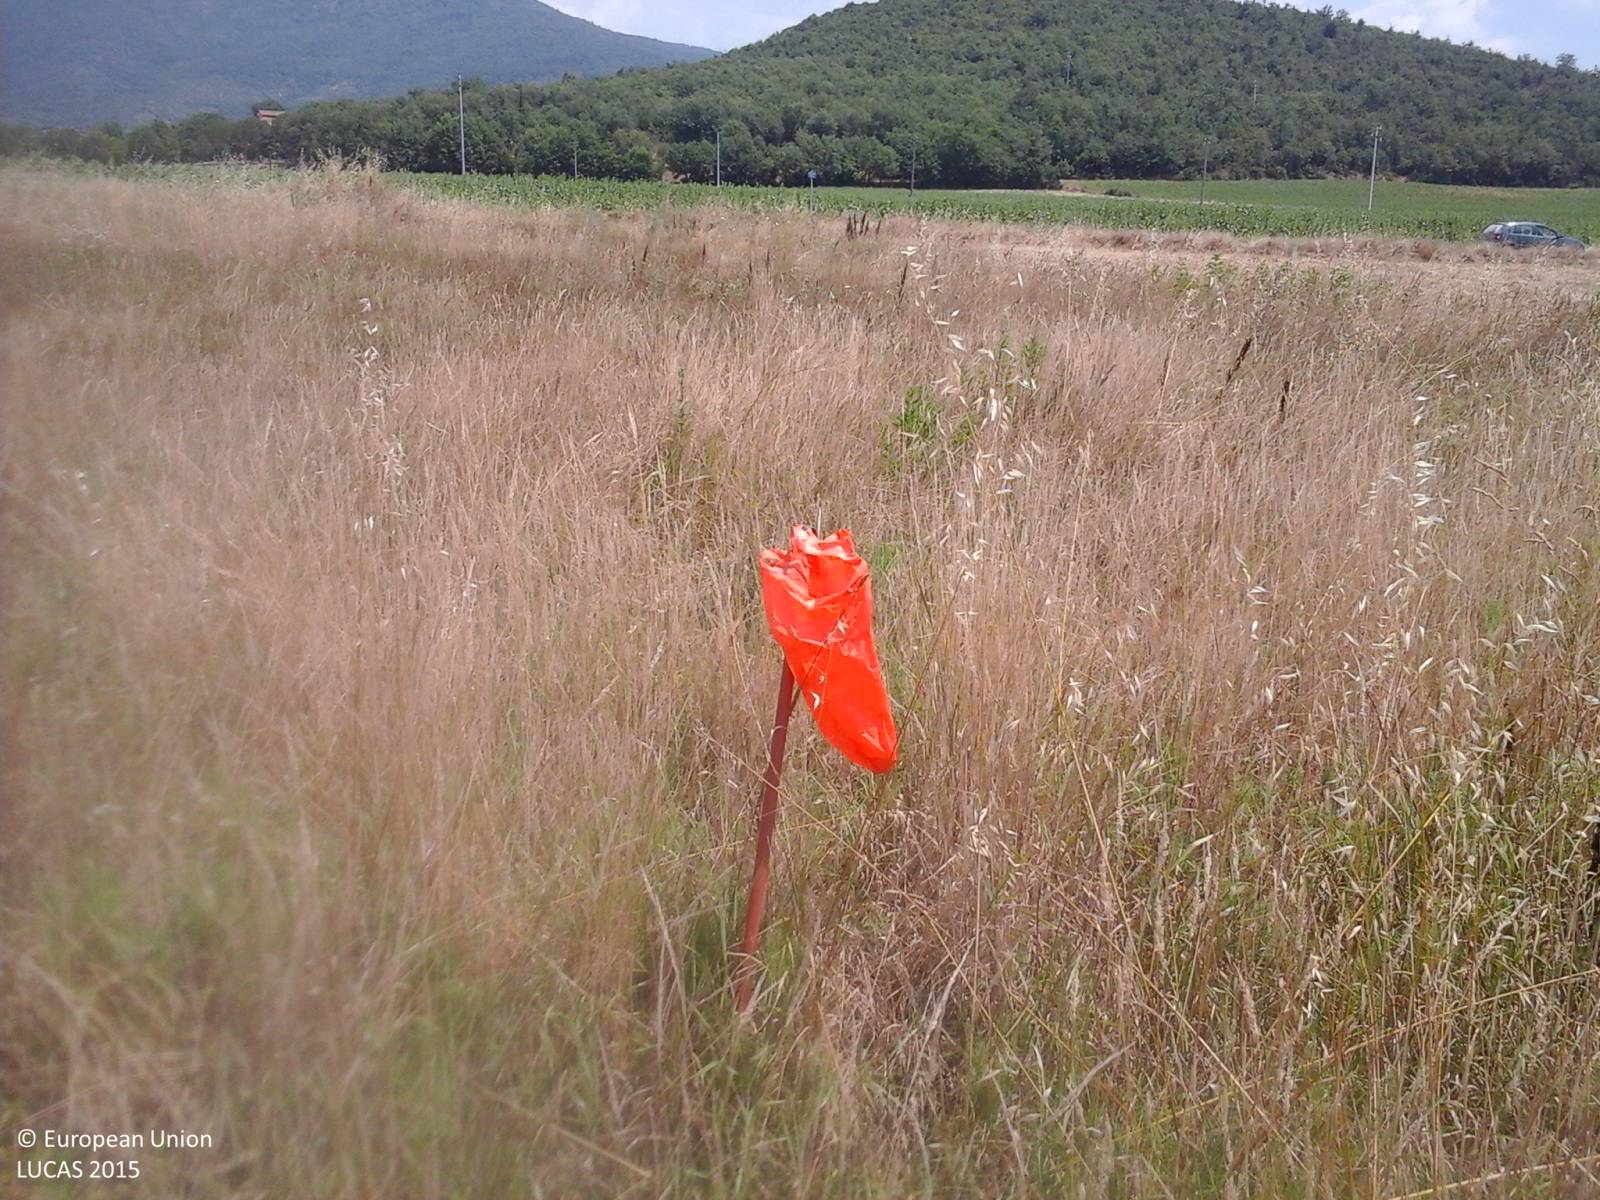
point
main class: Grassland
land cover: Spontaneously vegetated surfaces
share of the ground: > 75 %
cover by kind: herbaceous plants 100 %
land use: Fallow land
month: July
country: IT
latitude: 43.3589
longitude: 11.8826
